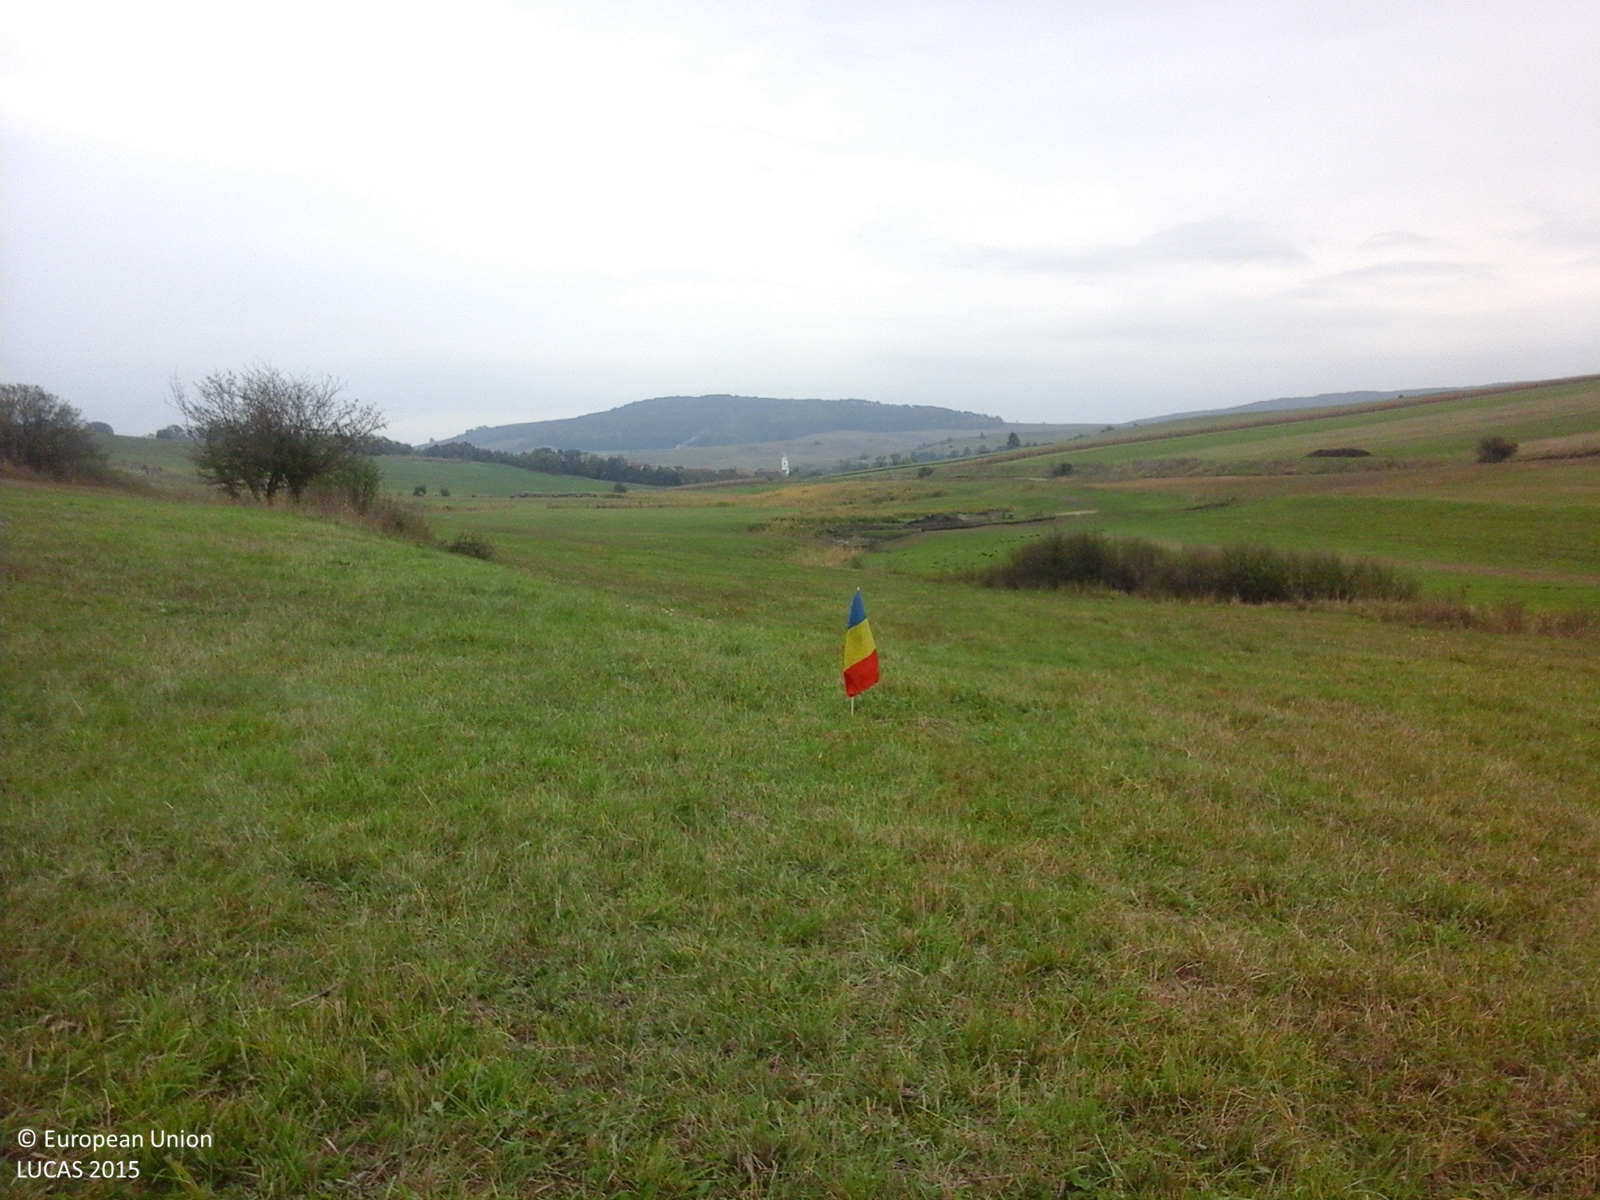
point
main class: Grassland
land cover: Grassland without tree/shrub cover
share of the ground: > 75 %
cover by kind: herbaceous plants 100 %
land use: Agriculture (excluding fallow land and kitchen gardens)
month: October
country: RO
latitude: 46.1317
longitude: 25.2304
